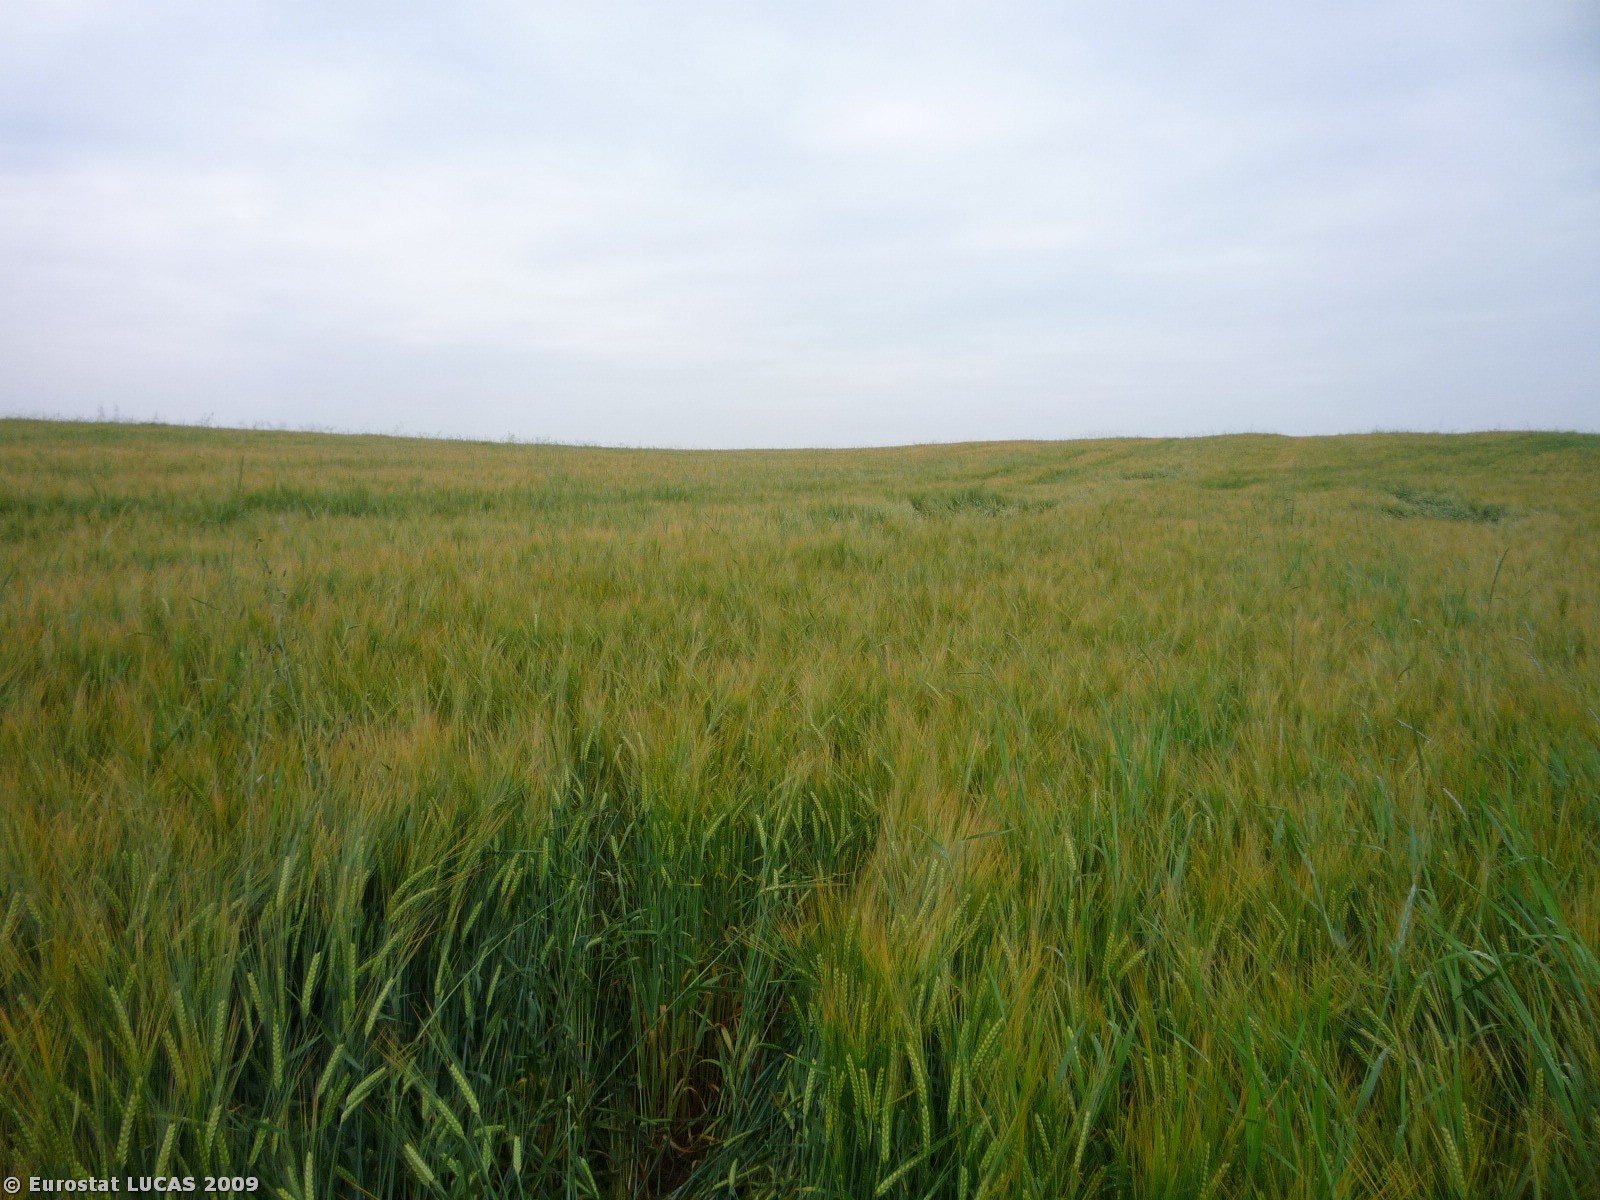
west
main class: Cropland
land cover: Barley
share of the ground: > 75 %
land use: Agriculture (excluding fallow land and kitchen gardens)
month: July
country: CZ
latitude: 50.0248
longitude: 14.9019
